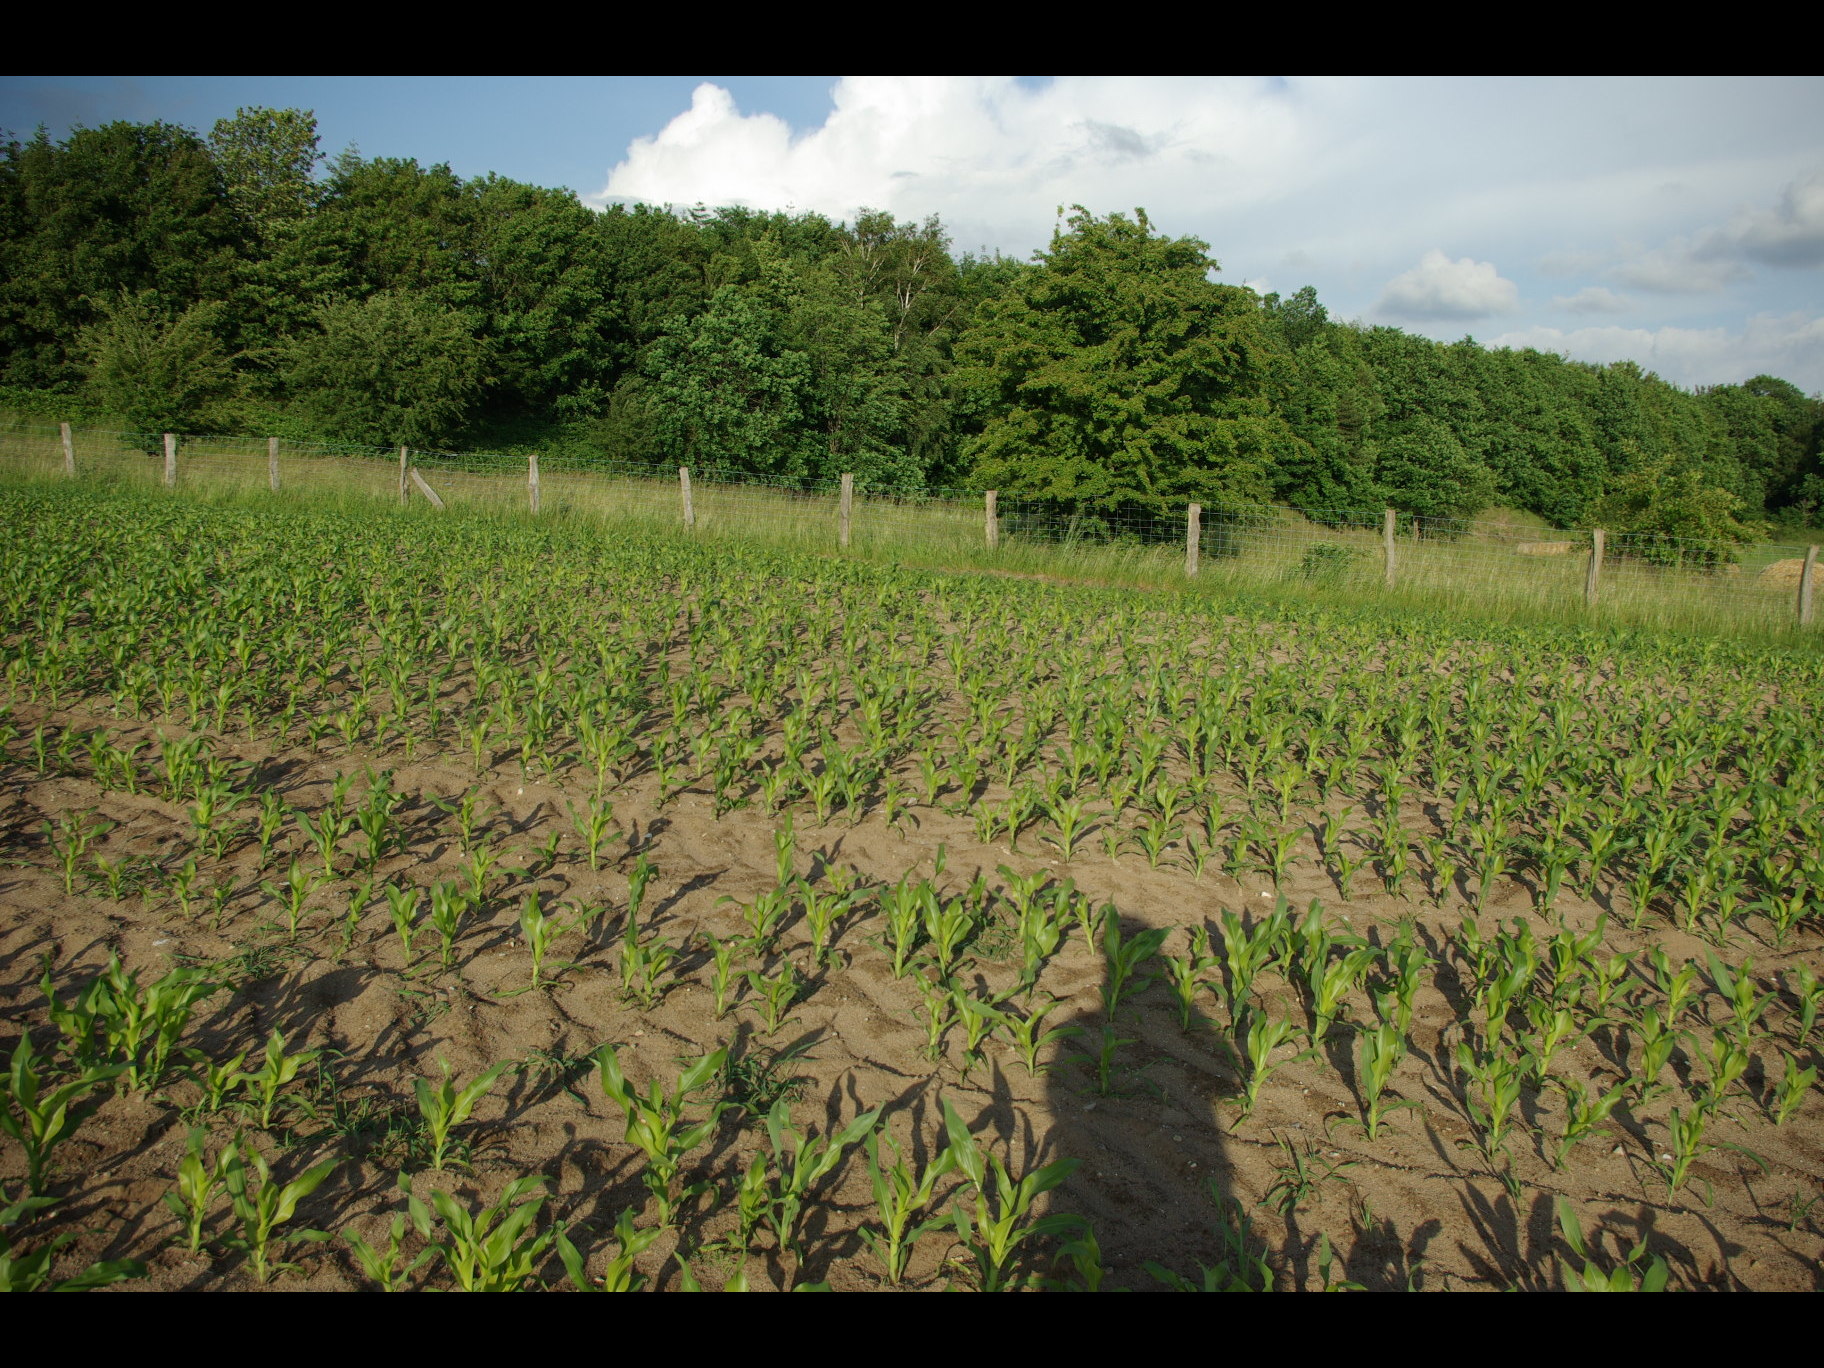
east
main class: Cropland
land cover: Maize
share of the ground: 25 - 50 %
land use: Agriculture (excluding fallow land and kitchen gardens)
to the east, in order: Maize; Fences; Grassland with sparse tree/shrub cover; Tracks; Spontaneously vegetated surfaces; Temporary grasslands; Groves; Broadleaved woodland; Paved roads, cycling and walking lanes; Other bare soil; Paved roads, cycling and walking lanes; Broadleaved woodland; Spruce dominated coniferous woodland; Spontaneously vegetated surfaces; Tracks; Grassland with sparse tree/shrub cover; Tracks; Spontaneously vegetated surfaces; Tracks; Spontaneously vegetated surfaces
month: June
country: DE
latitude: 54.2106
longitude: 9.8927
